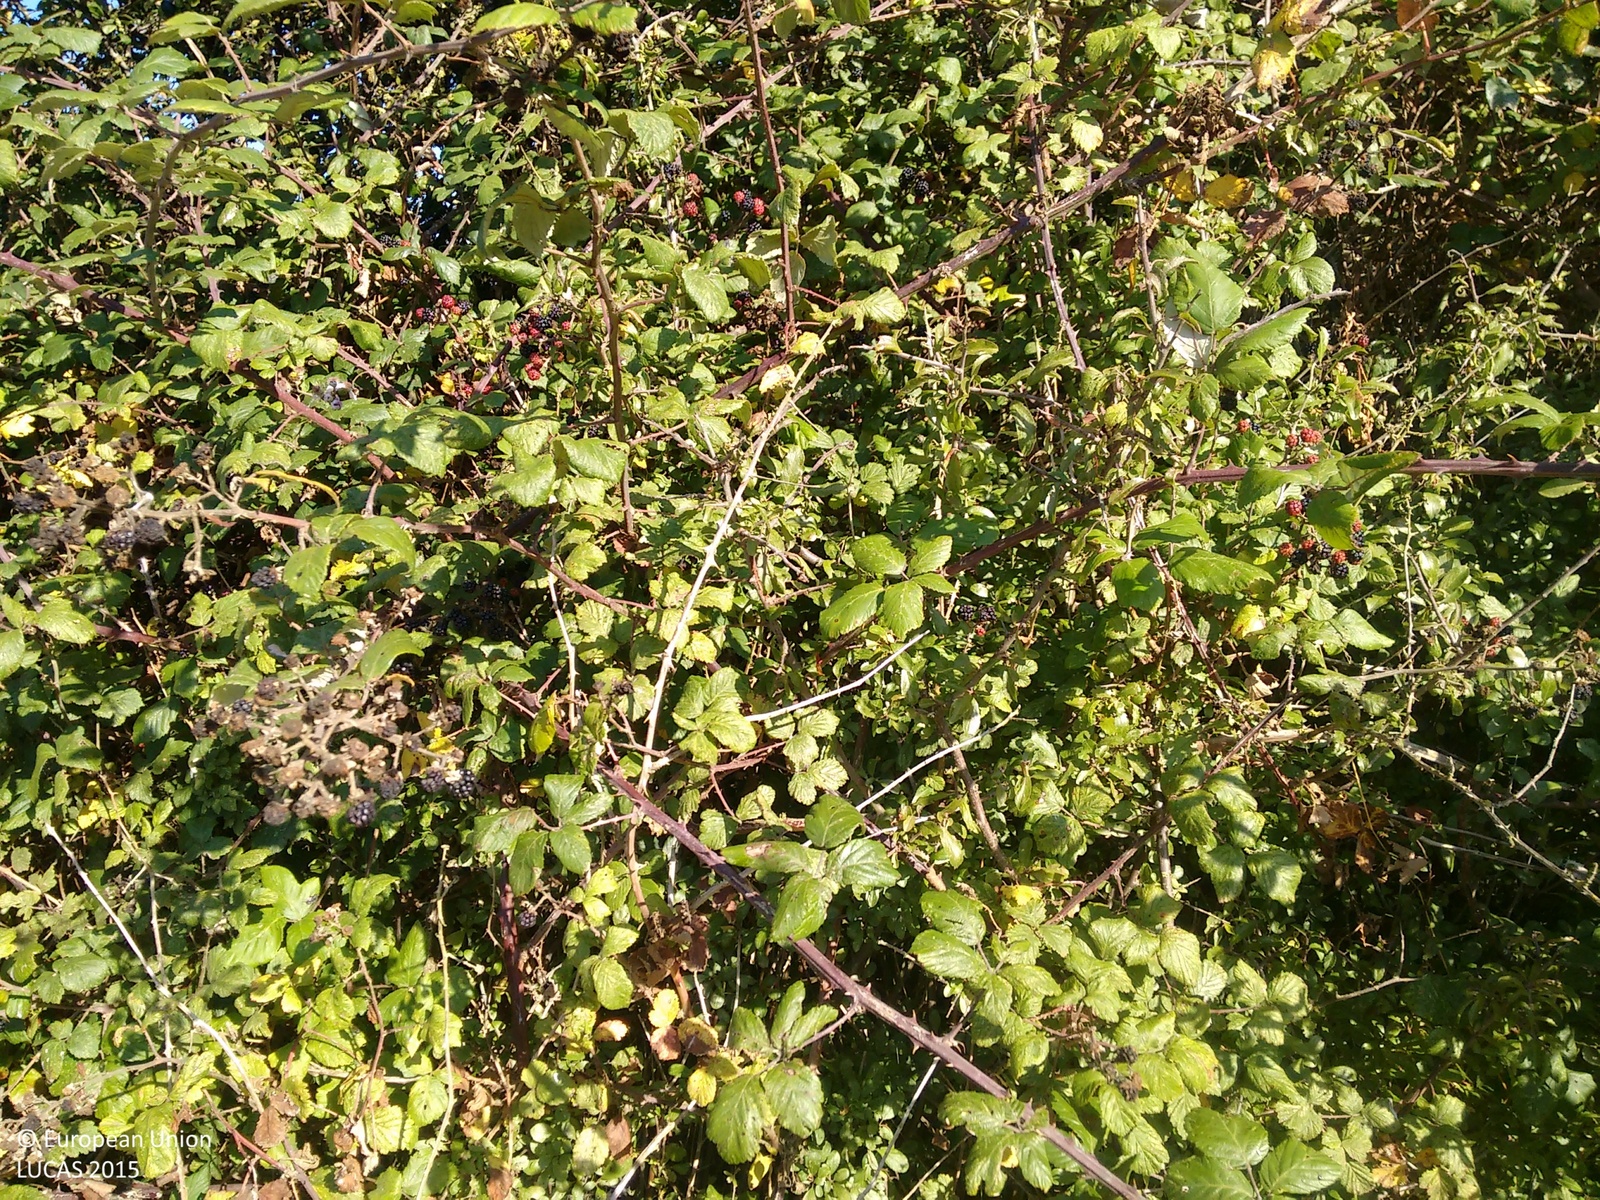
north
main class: Shrubland
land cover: Shrubland without tree cover
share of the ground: > 75 %
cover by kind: shrubs 100 %
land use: Agriculture (excluding fallow land and kitchen gardens)
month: September
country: GB
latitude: 52.3404
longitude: -0.3549
